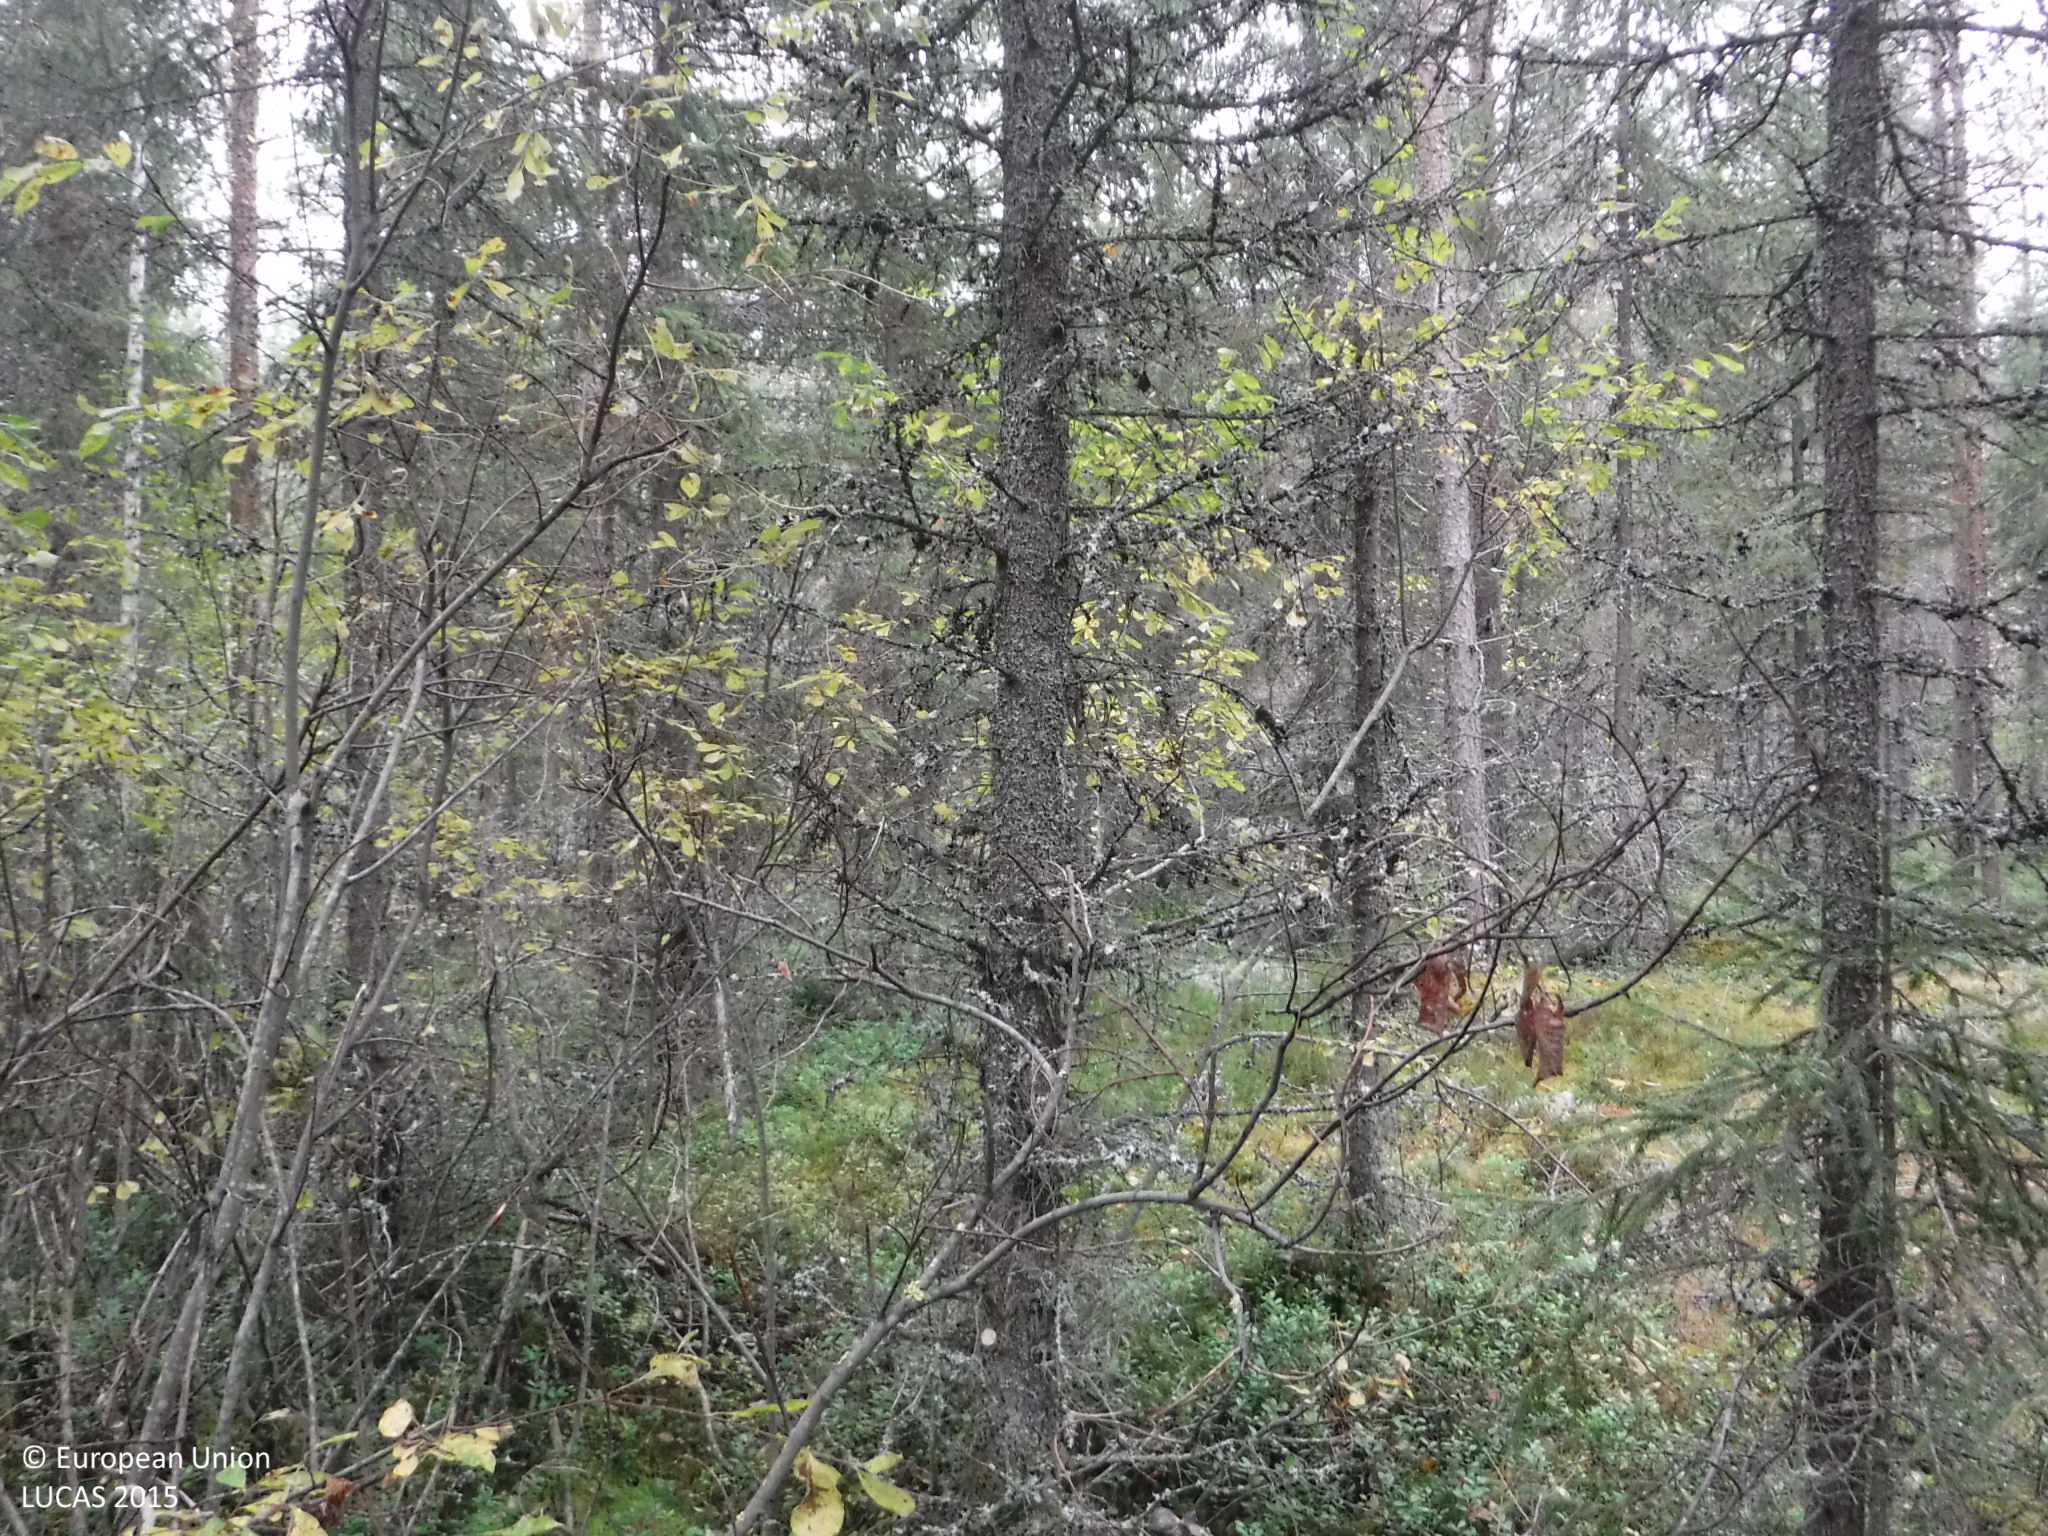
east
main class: Woodland
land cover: Other mixed woodland
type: boreal forest
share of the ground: 50 - 75 %
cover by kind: coniferous forest trees 30 %, shrubs 30 %, broadleaved forest trees 25 %, lichens and mosses 15 %
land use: Forestry
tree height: > 5 m
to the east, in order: Other mixed woodland; Pine dominated coniferous woodland; Other coniferous woodland; Spruce dominated coniferous woodland; Ditches and canals; Spruce dominated coniferous woodland
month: September
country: FI
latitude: 62.0708
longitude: 23.3347
